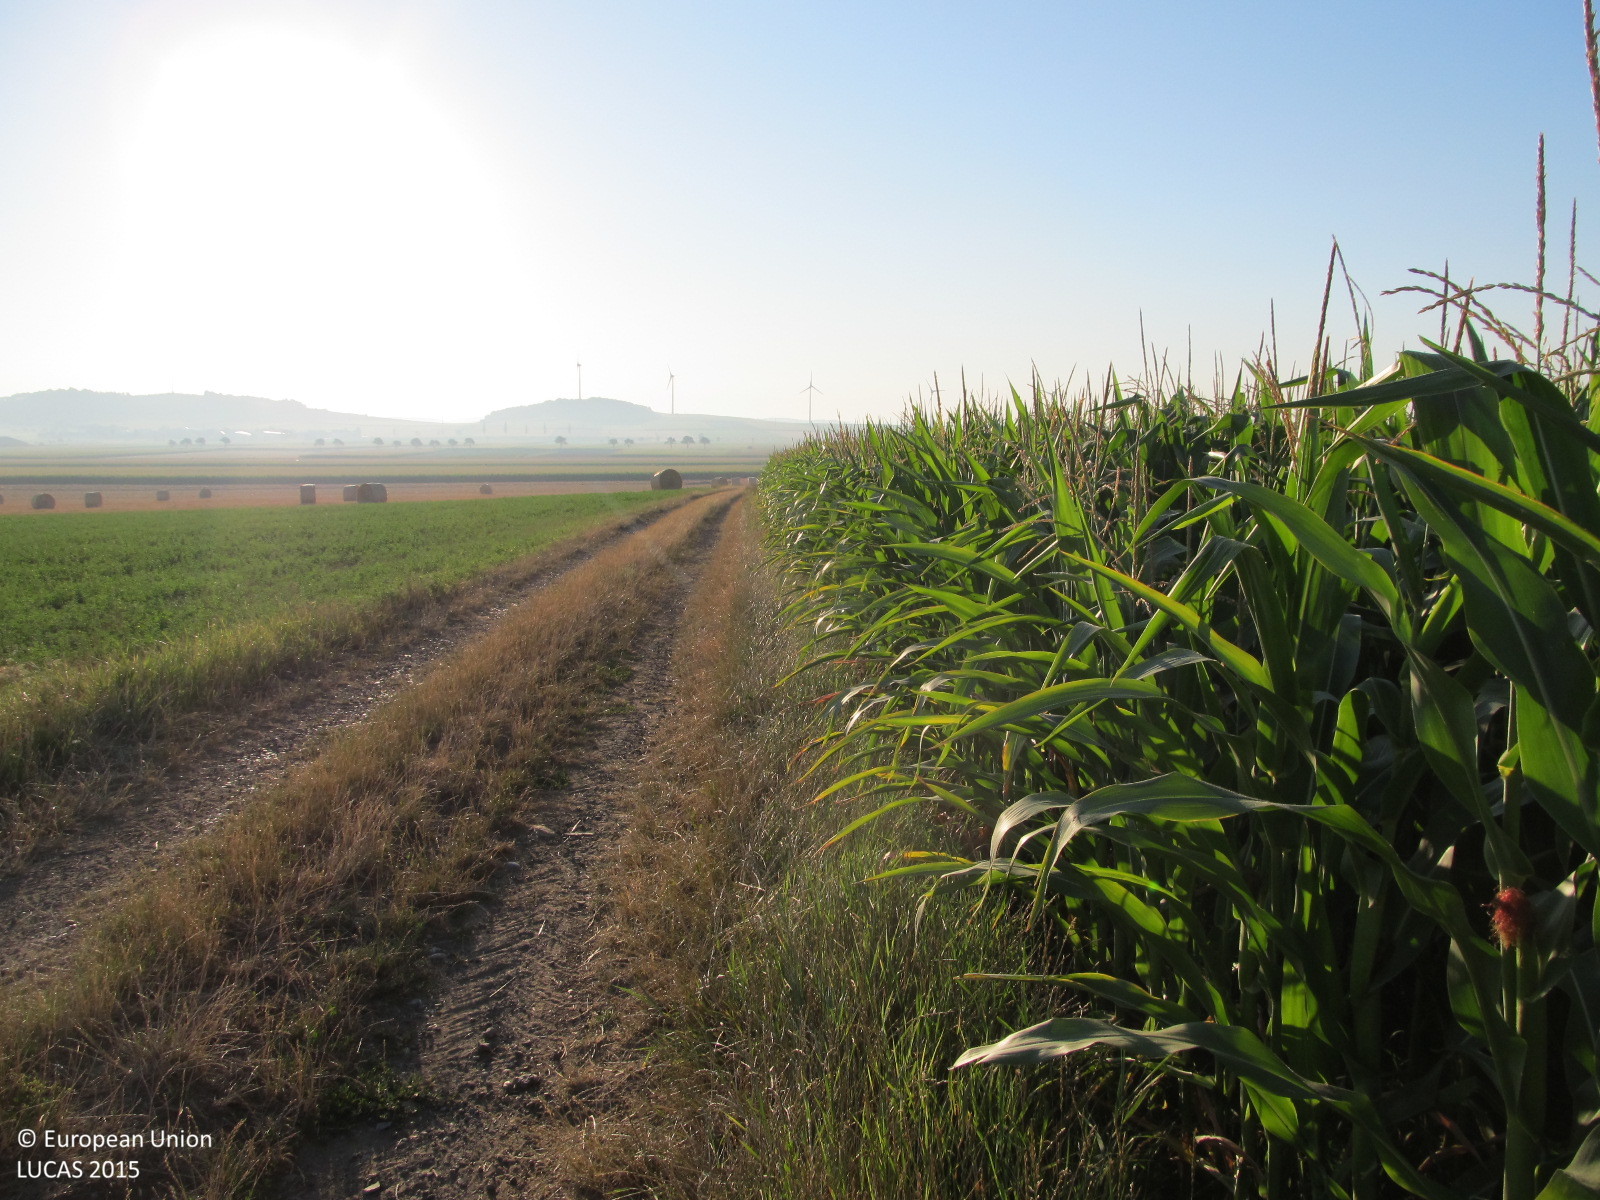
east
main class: Cropland
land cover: Maize
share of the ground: > 75 %
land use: Agriculture (excluding fallow land and kitchen gardens)
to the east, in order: Maize; Common wheat; Maize
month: July
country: AT
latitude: 48.2785
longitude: 15.6219
